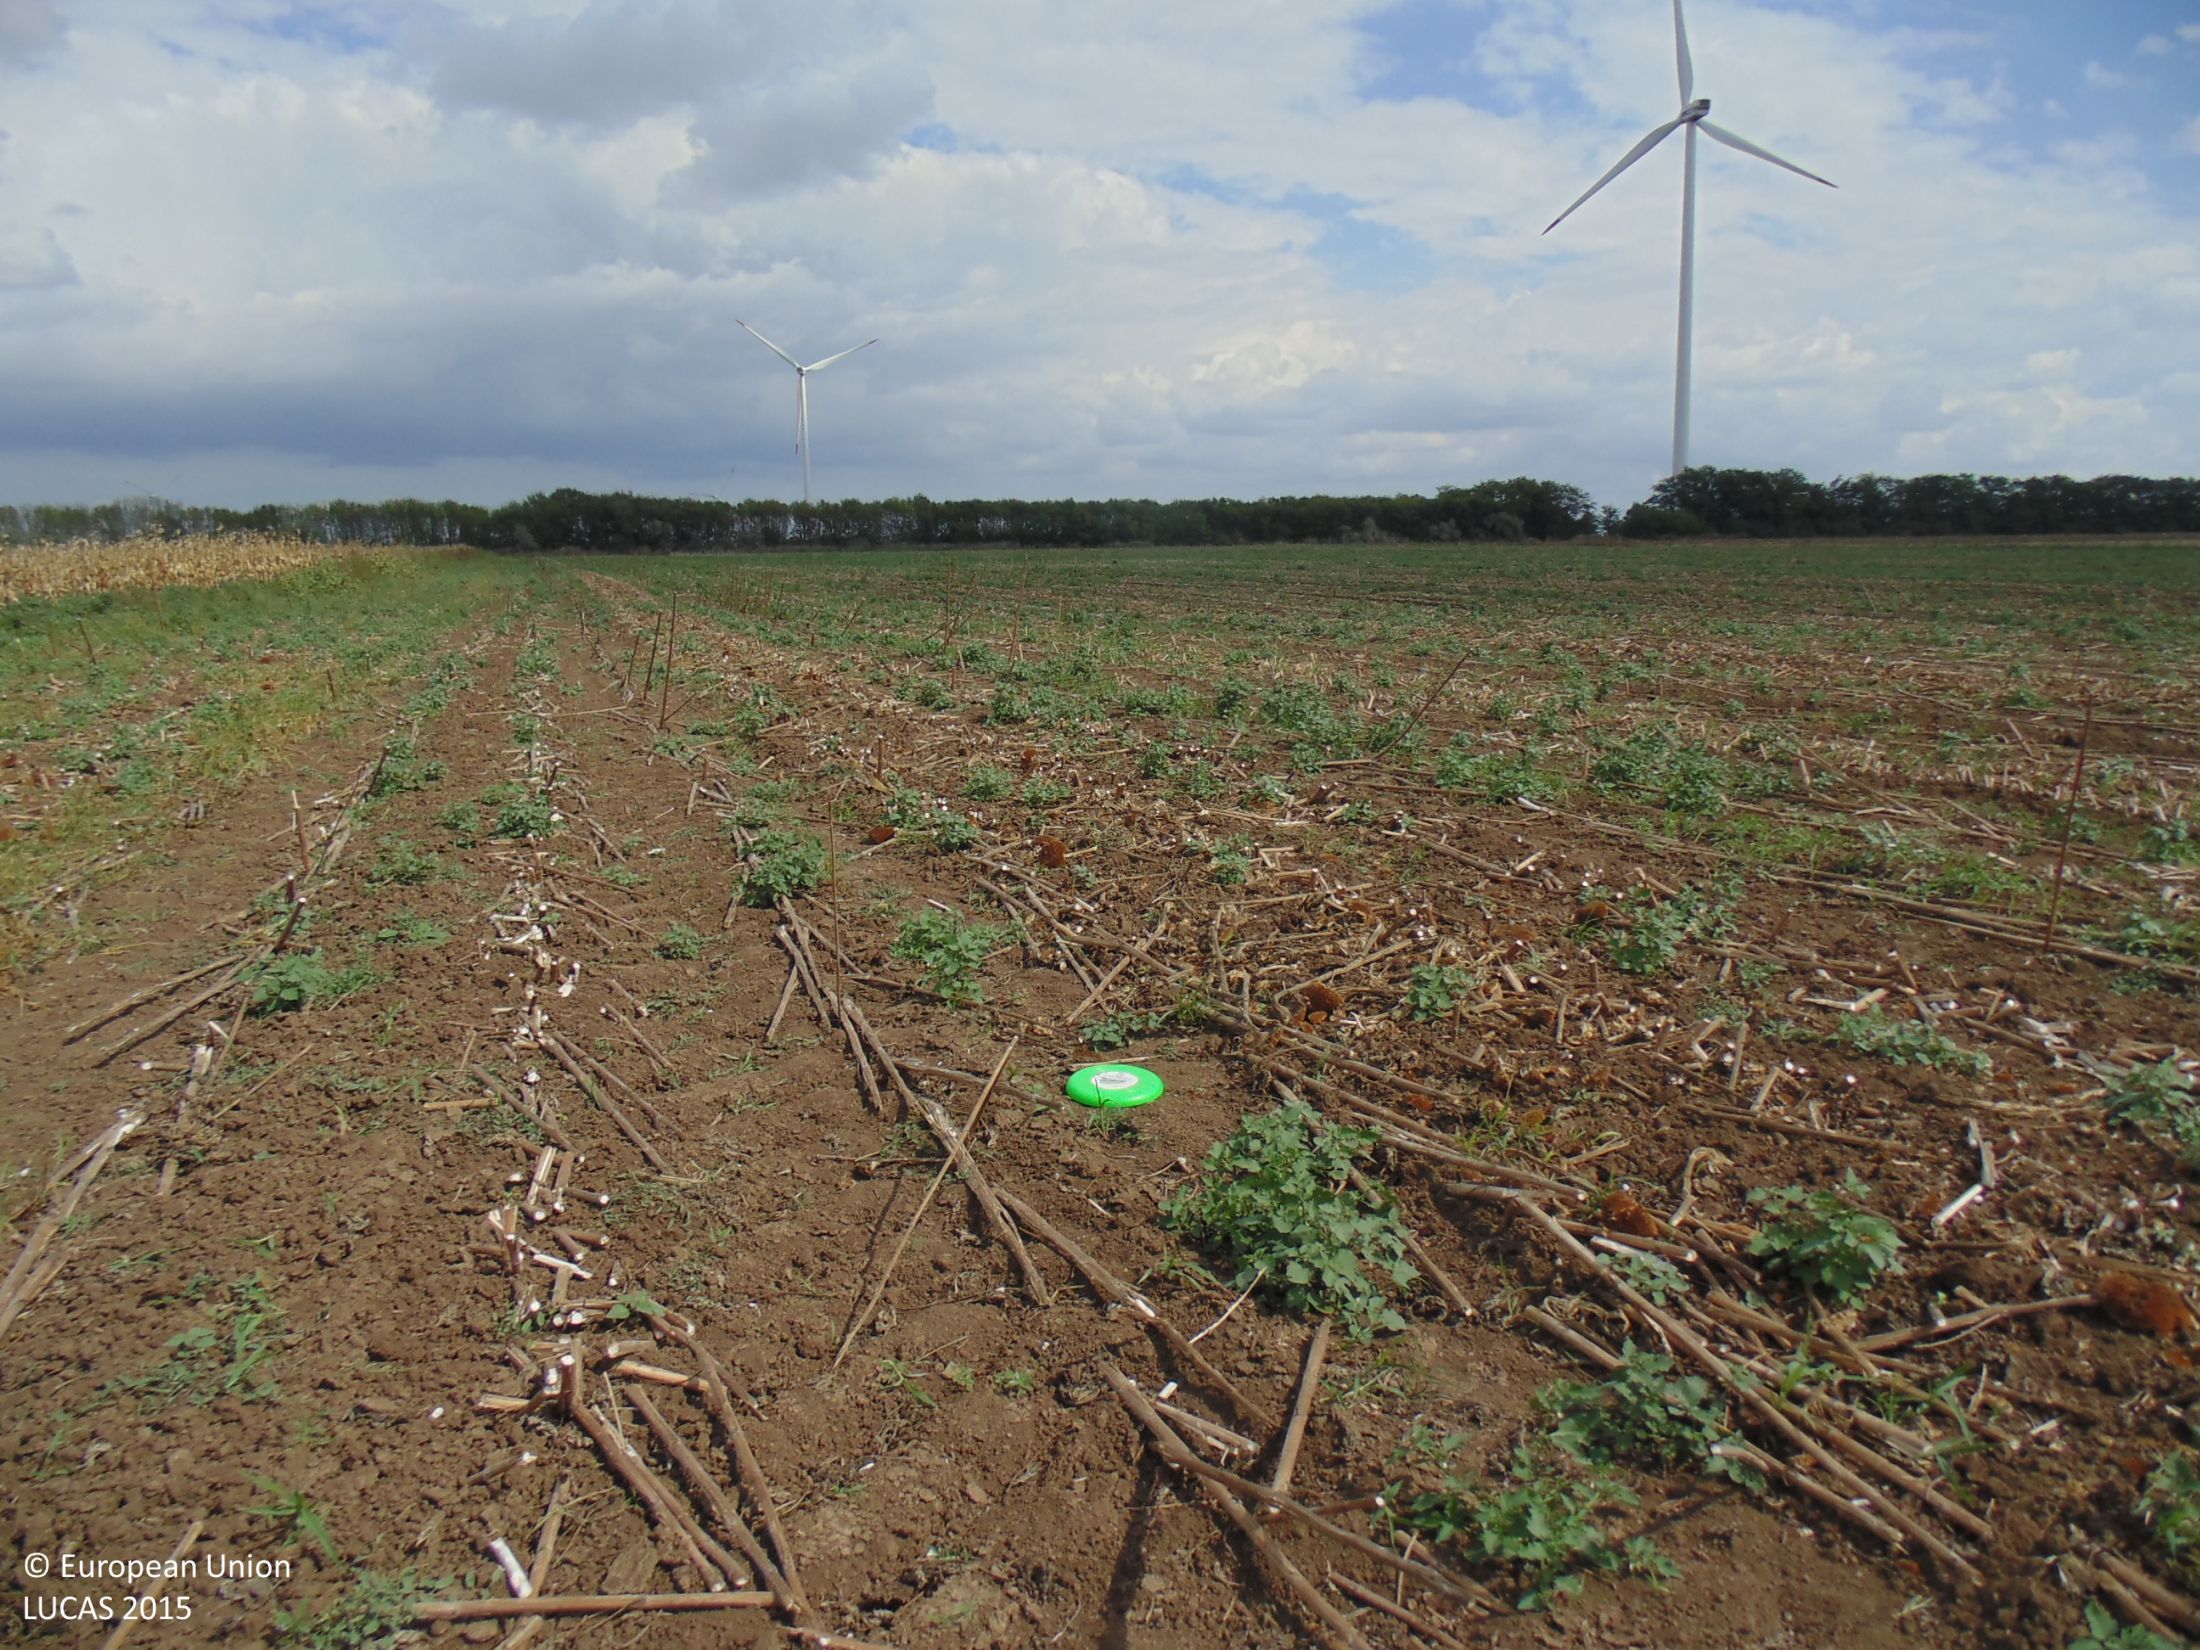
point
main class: Cropland
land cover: Sunflower
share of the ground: < 10 %
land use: Agriculture (excluding fallow land and kitchen gardens)
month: September
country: BG
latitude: 43.4346
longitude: 28.4552
